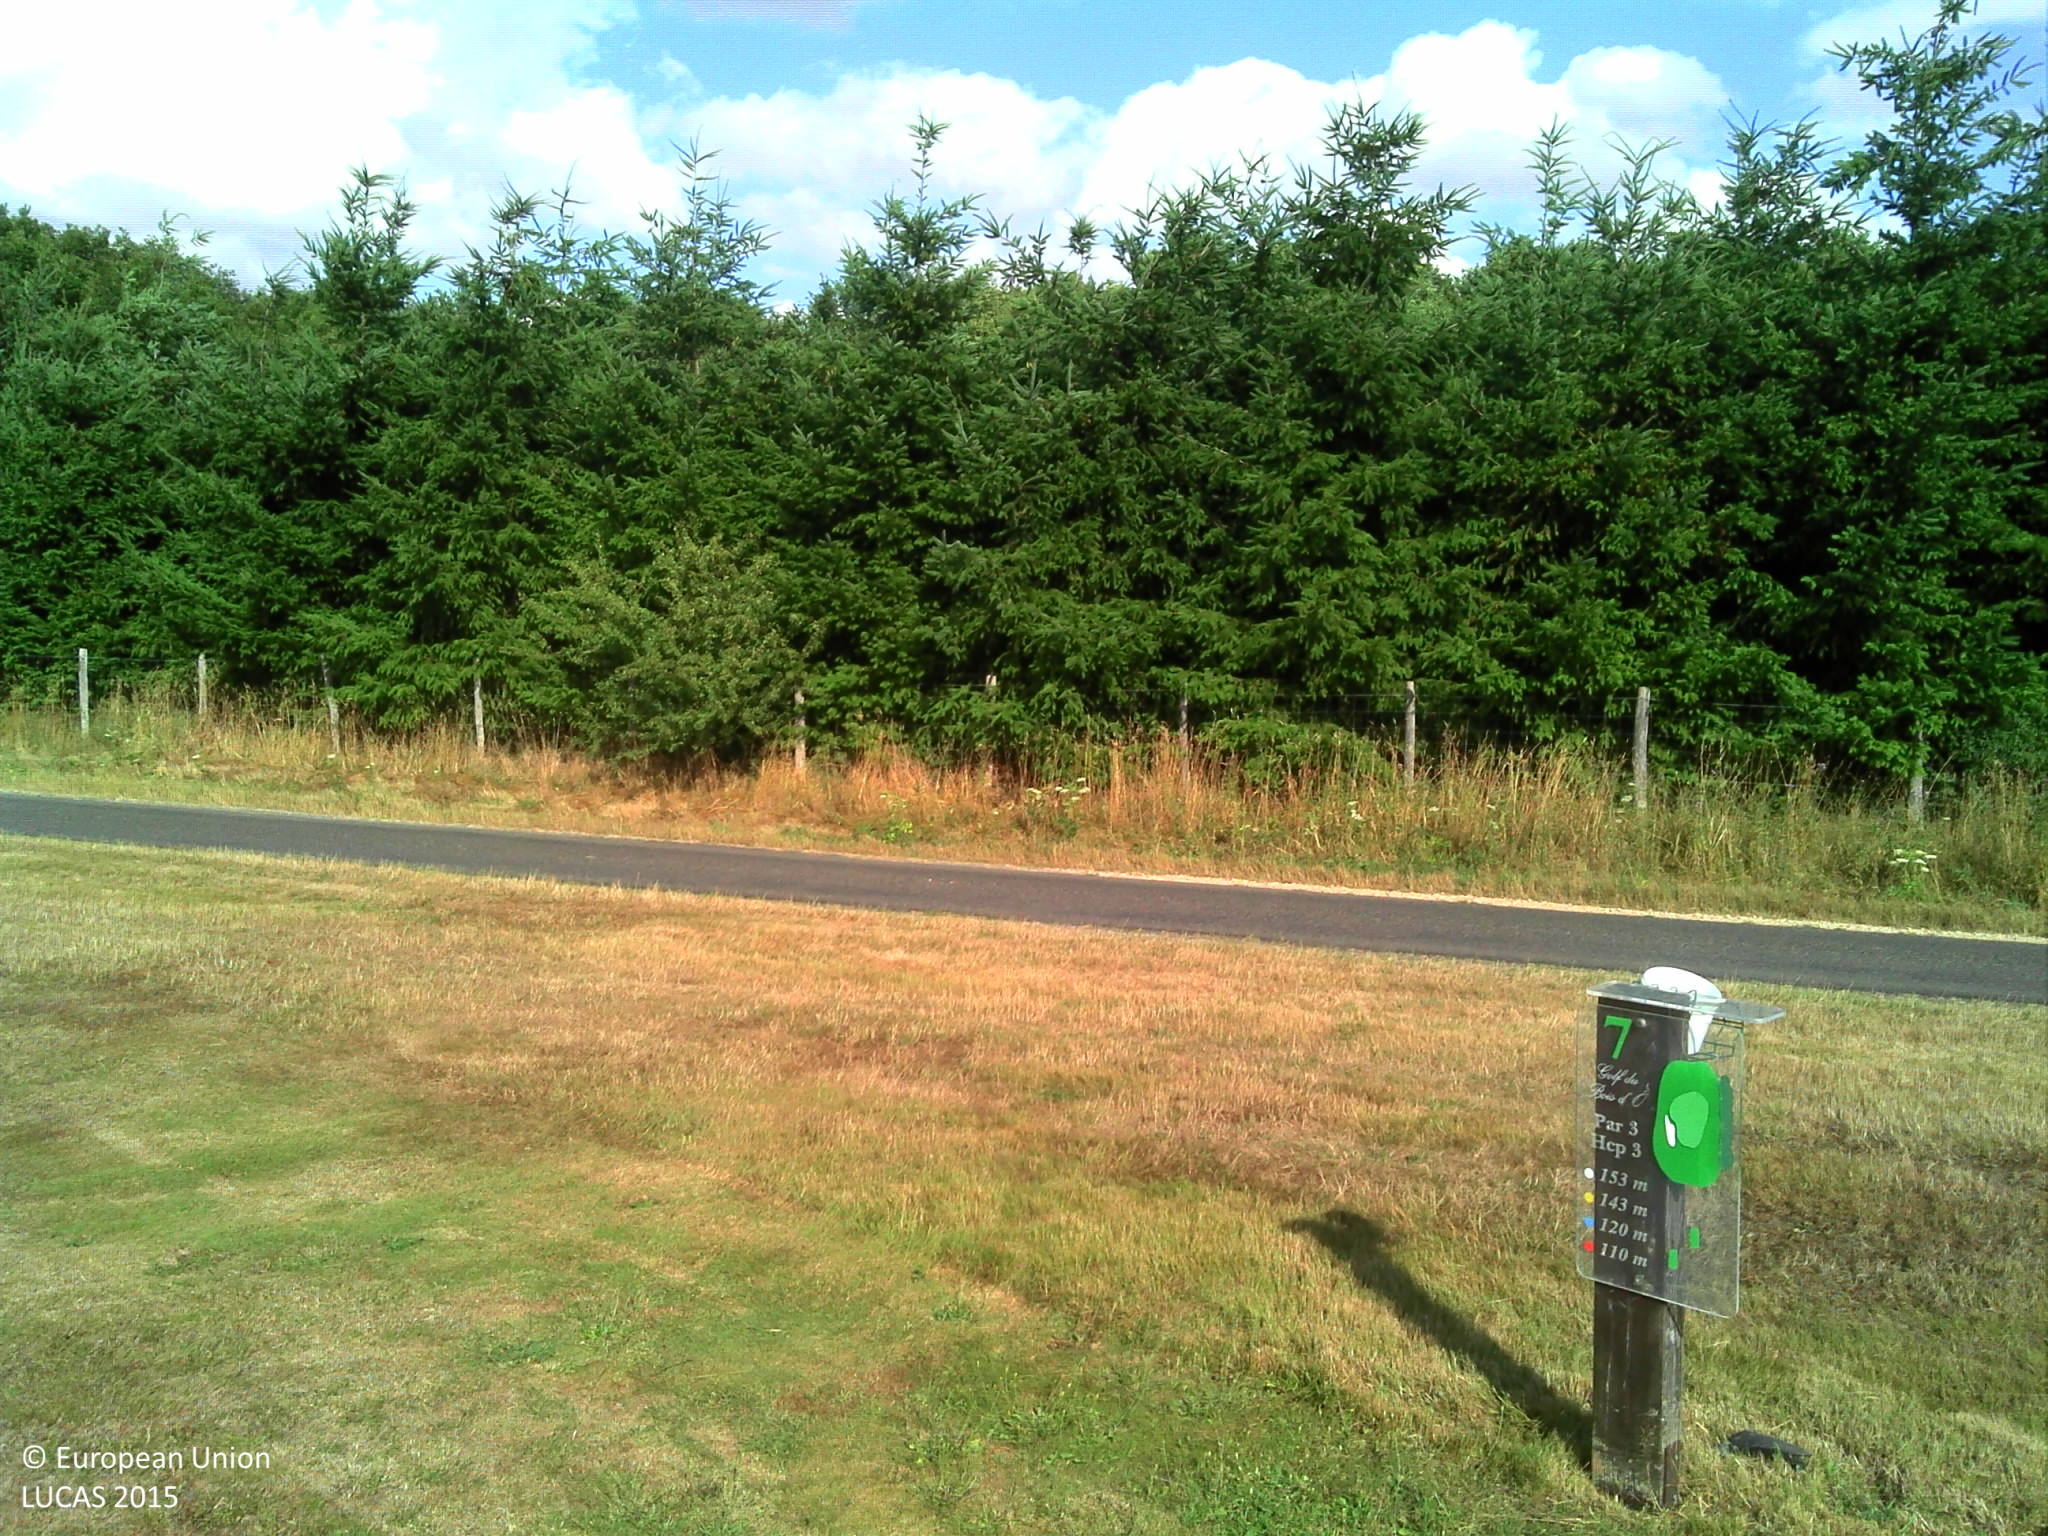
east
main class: Grassland
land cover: Grassland without tree/shrub cover
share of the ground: > 75 %
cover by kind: herbaceous plants 100 %
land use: Sport
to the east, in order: Grassland without tree/shrub cover; Paved roads, cycling and walking lanes; Grass margins; Fences; Spruce dominated coniferous woodland; Fences; Broadleaved woodland; Tracks; Broadleaved woodland
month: July
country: FR
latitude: 48.5956
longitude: 1.2080
